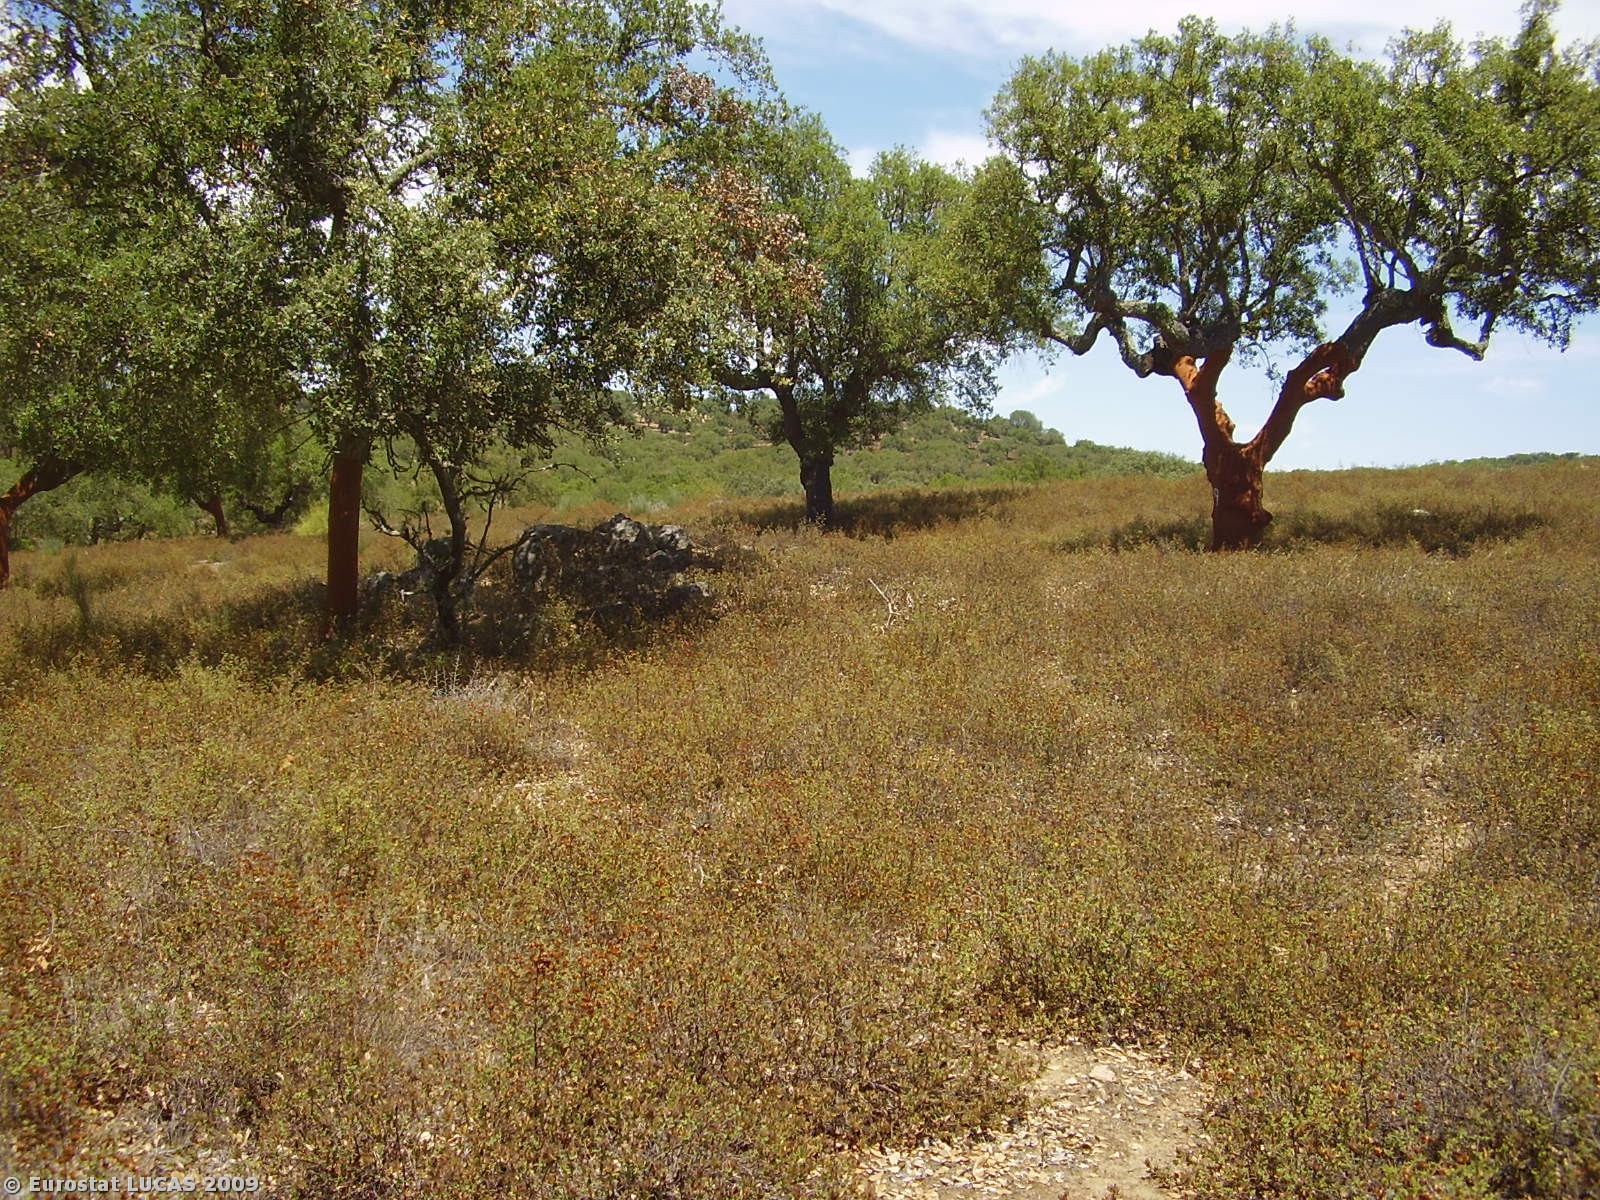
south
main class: Woodland
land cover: Broadleaved woodland
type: broadleaved evergreen forest
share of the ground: 10 - 25 %
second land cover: Spontaneously vegetated surfaces
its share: 50 - 75 %
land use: Forestry
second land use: Fallow land
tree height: > 5 m
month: July
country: PT
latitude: 38.7247
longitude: -7.8582
